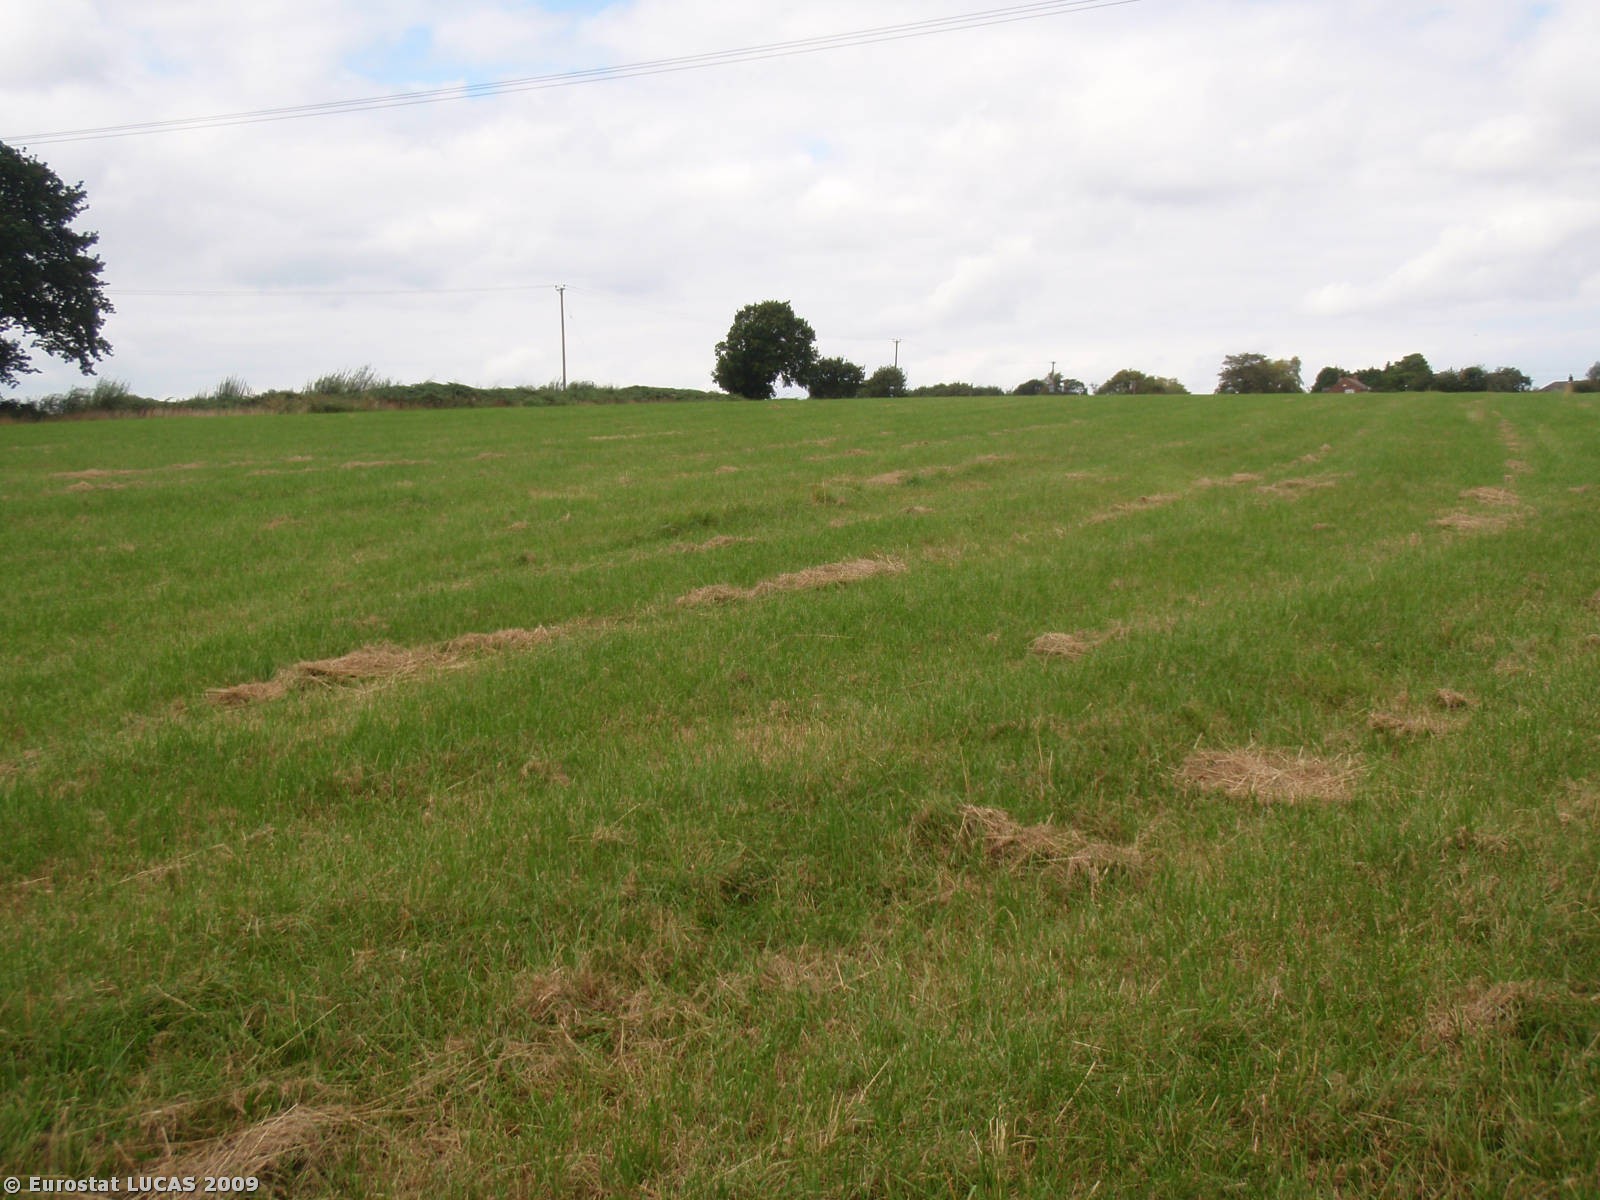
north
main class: Grassland
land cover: Grassland without tree/shrub cover
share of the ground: > 75 %
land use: Agriculture (excluding fallow land and kitchen gardens)
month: August
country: GB
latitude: 50.7590
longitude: -2.0664
